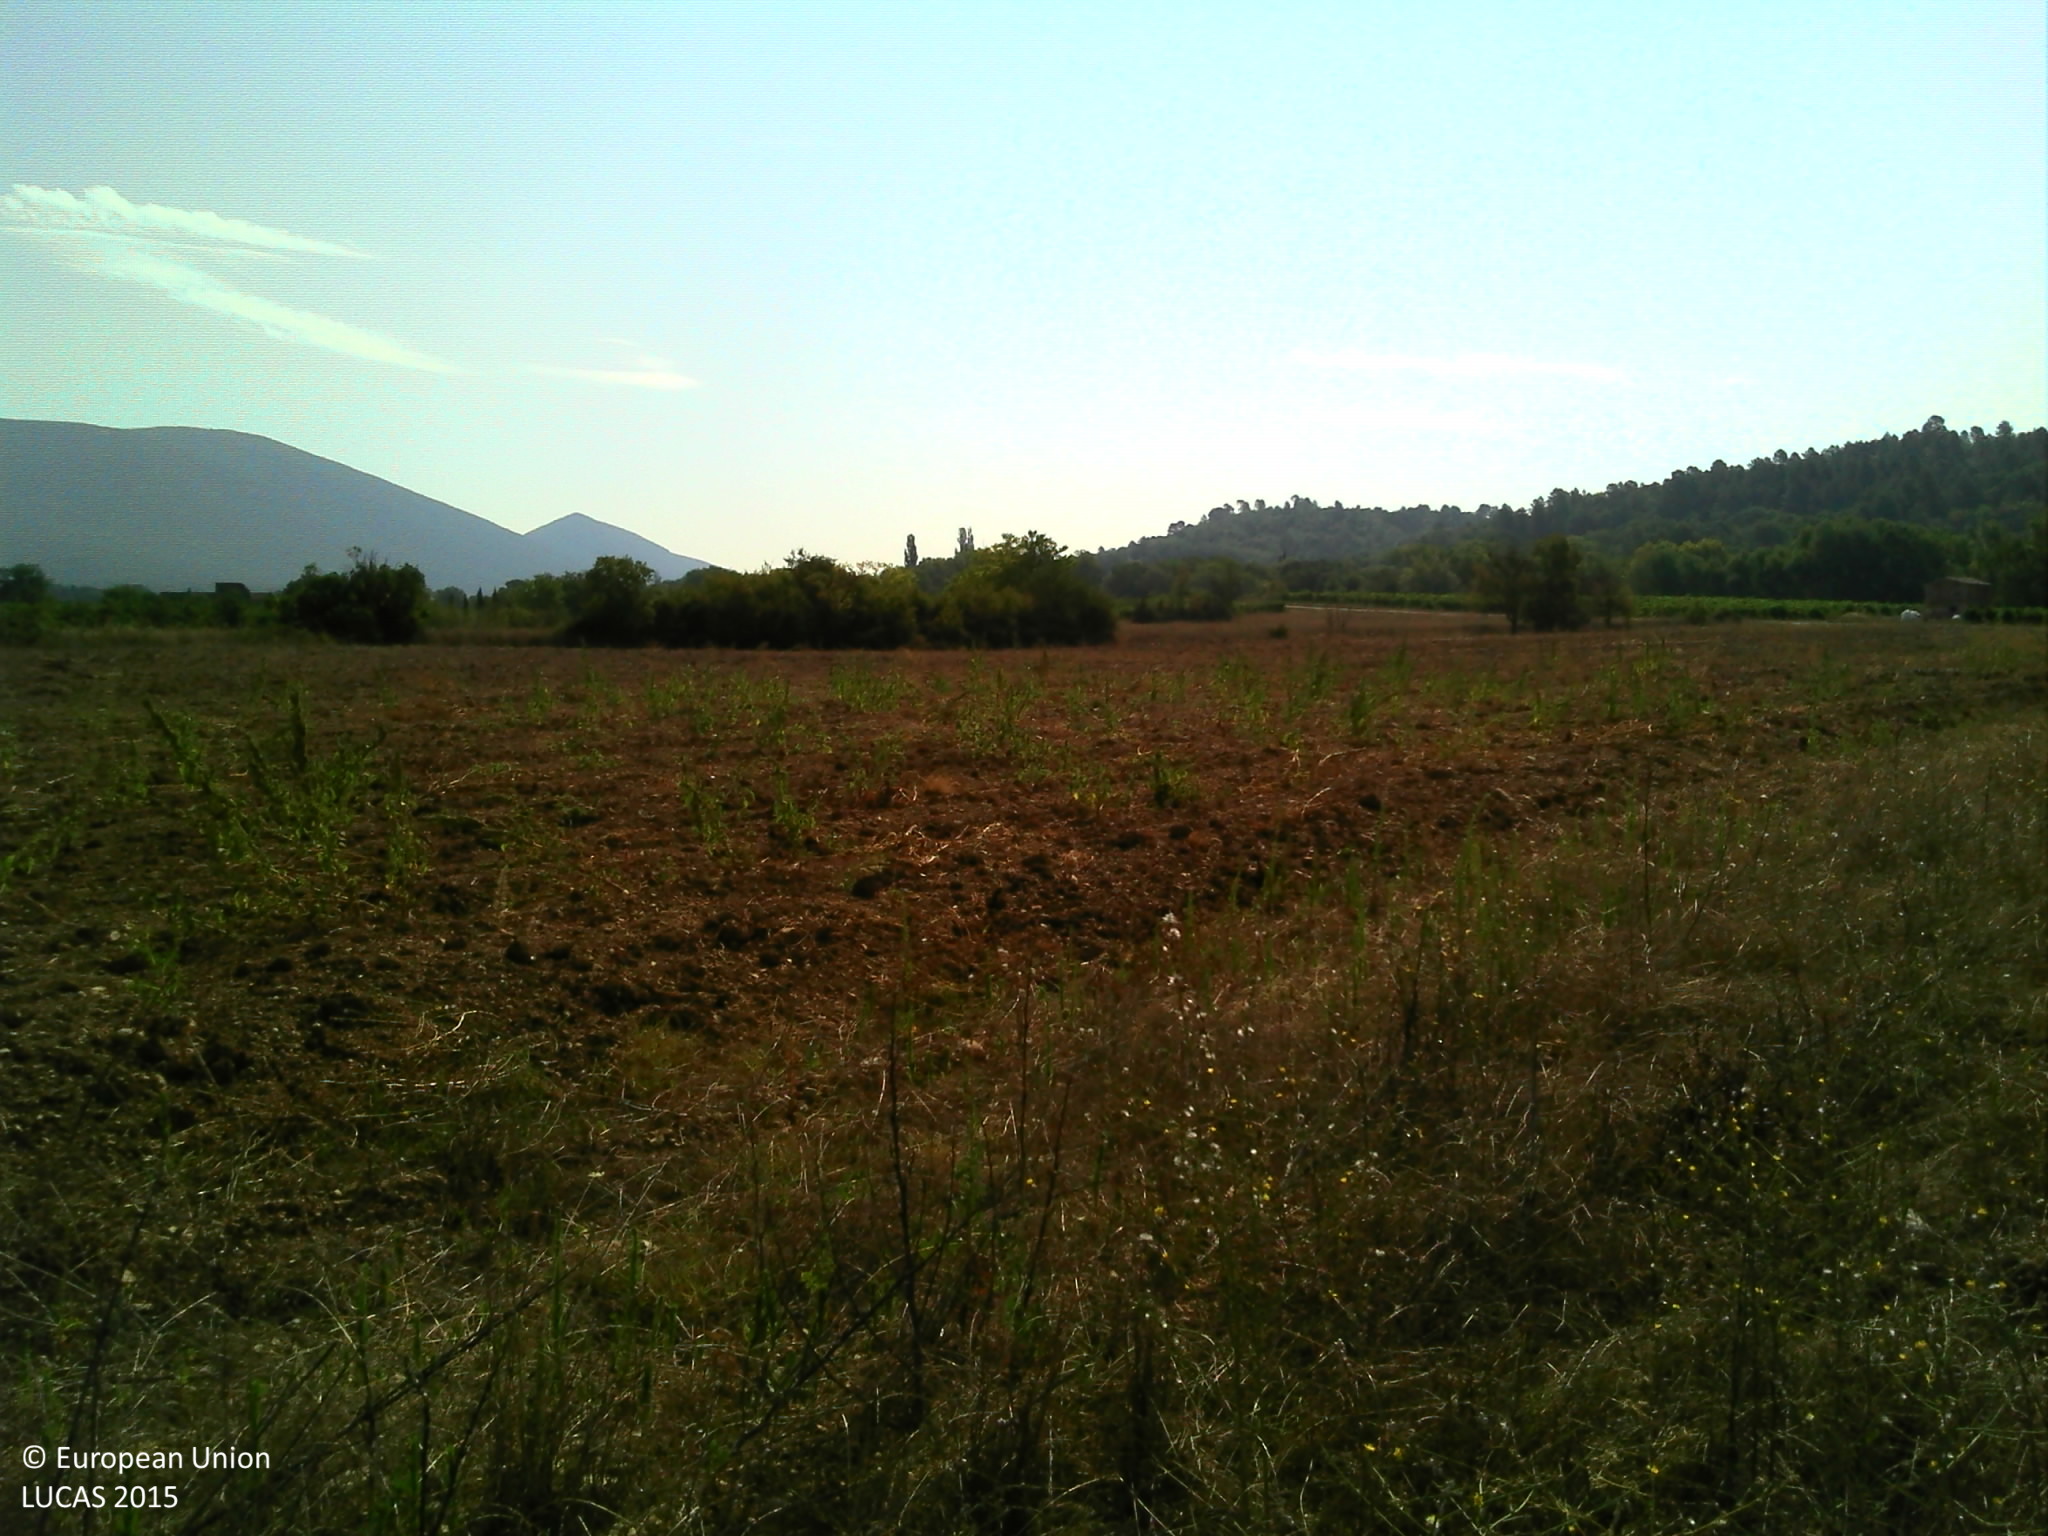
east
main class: Grassland
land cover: Spontaneously vegetated surfaces
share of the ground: > 75 %
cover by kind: herbaceous plants 70 %, unconsolidated bare surface 30 %
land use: Semi-natural and natural areas not in use
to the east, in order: Spontaneously vegetated surfaces; Other bare soil; Broadleaved woodland; Tracks; Grassland with sparse tree/shrub cover; Abandoned hedges; Grassland without tree/shrub cover
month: August
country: FR
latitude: 43.9240
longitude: 5.4127
